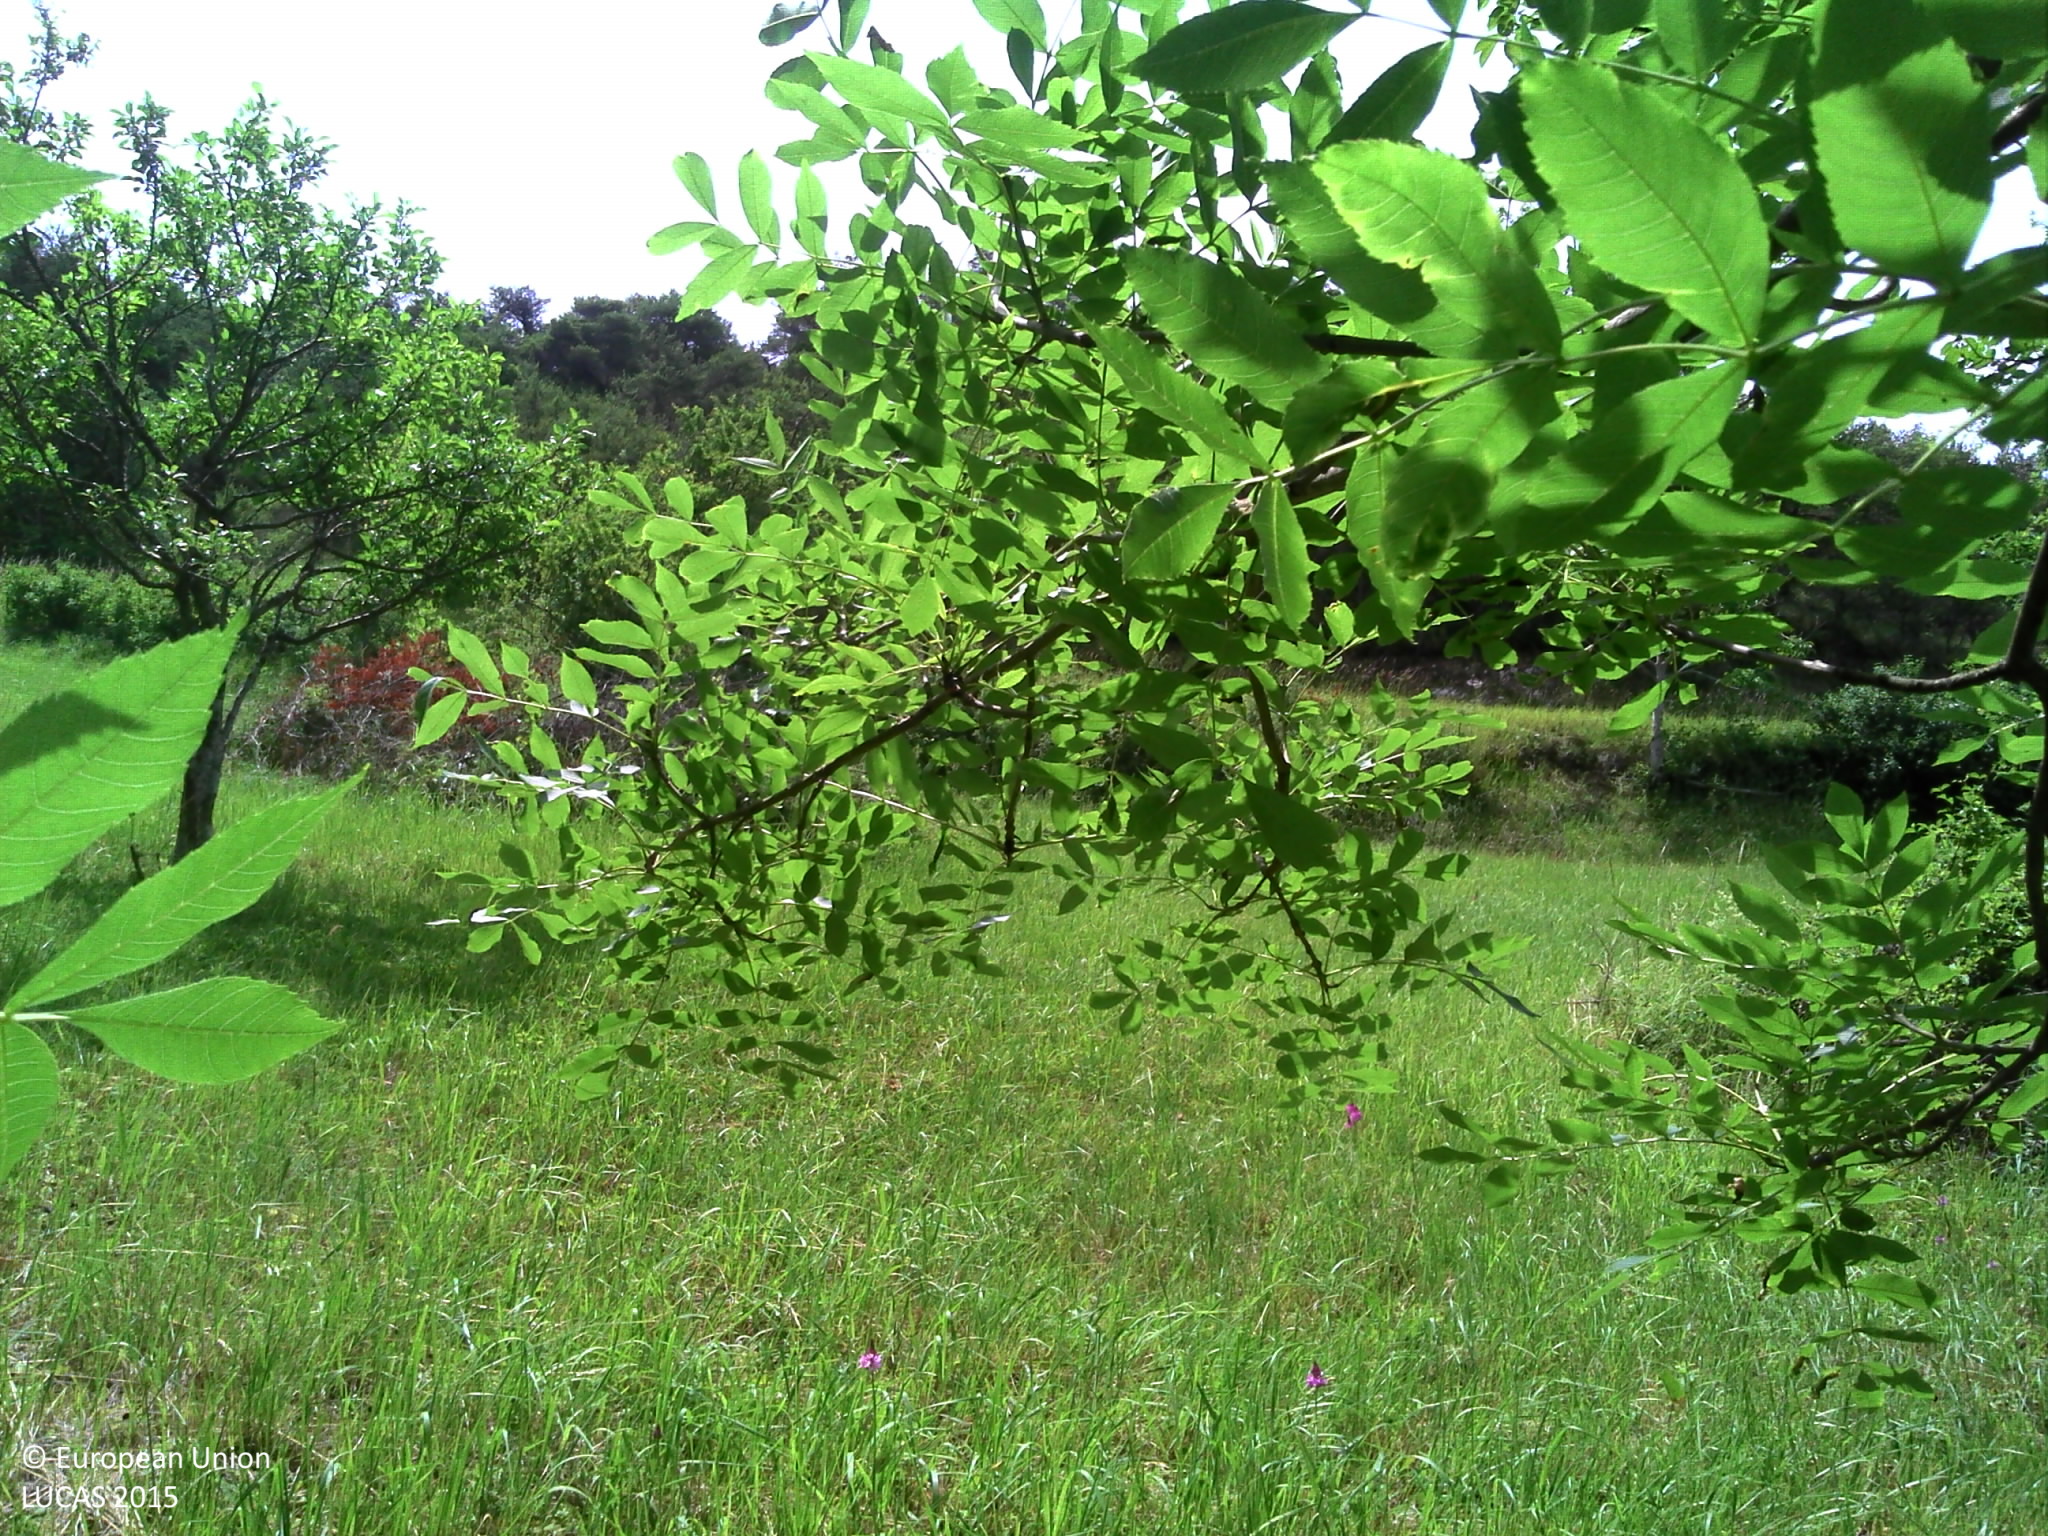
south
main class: Woodland
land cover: Broadleaved woodland
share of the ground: > 75 %
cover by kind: herbaceous plants 85 %, broadleaved forest trees 10 %, shrubs 5 %
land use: Agriculture (excluding fallow land and kitchen gardens)
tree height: > 5 m
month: June
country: FR
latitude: 44.7462
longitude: 5.2195
